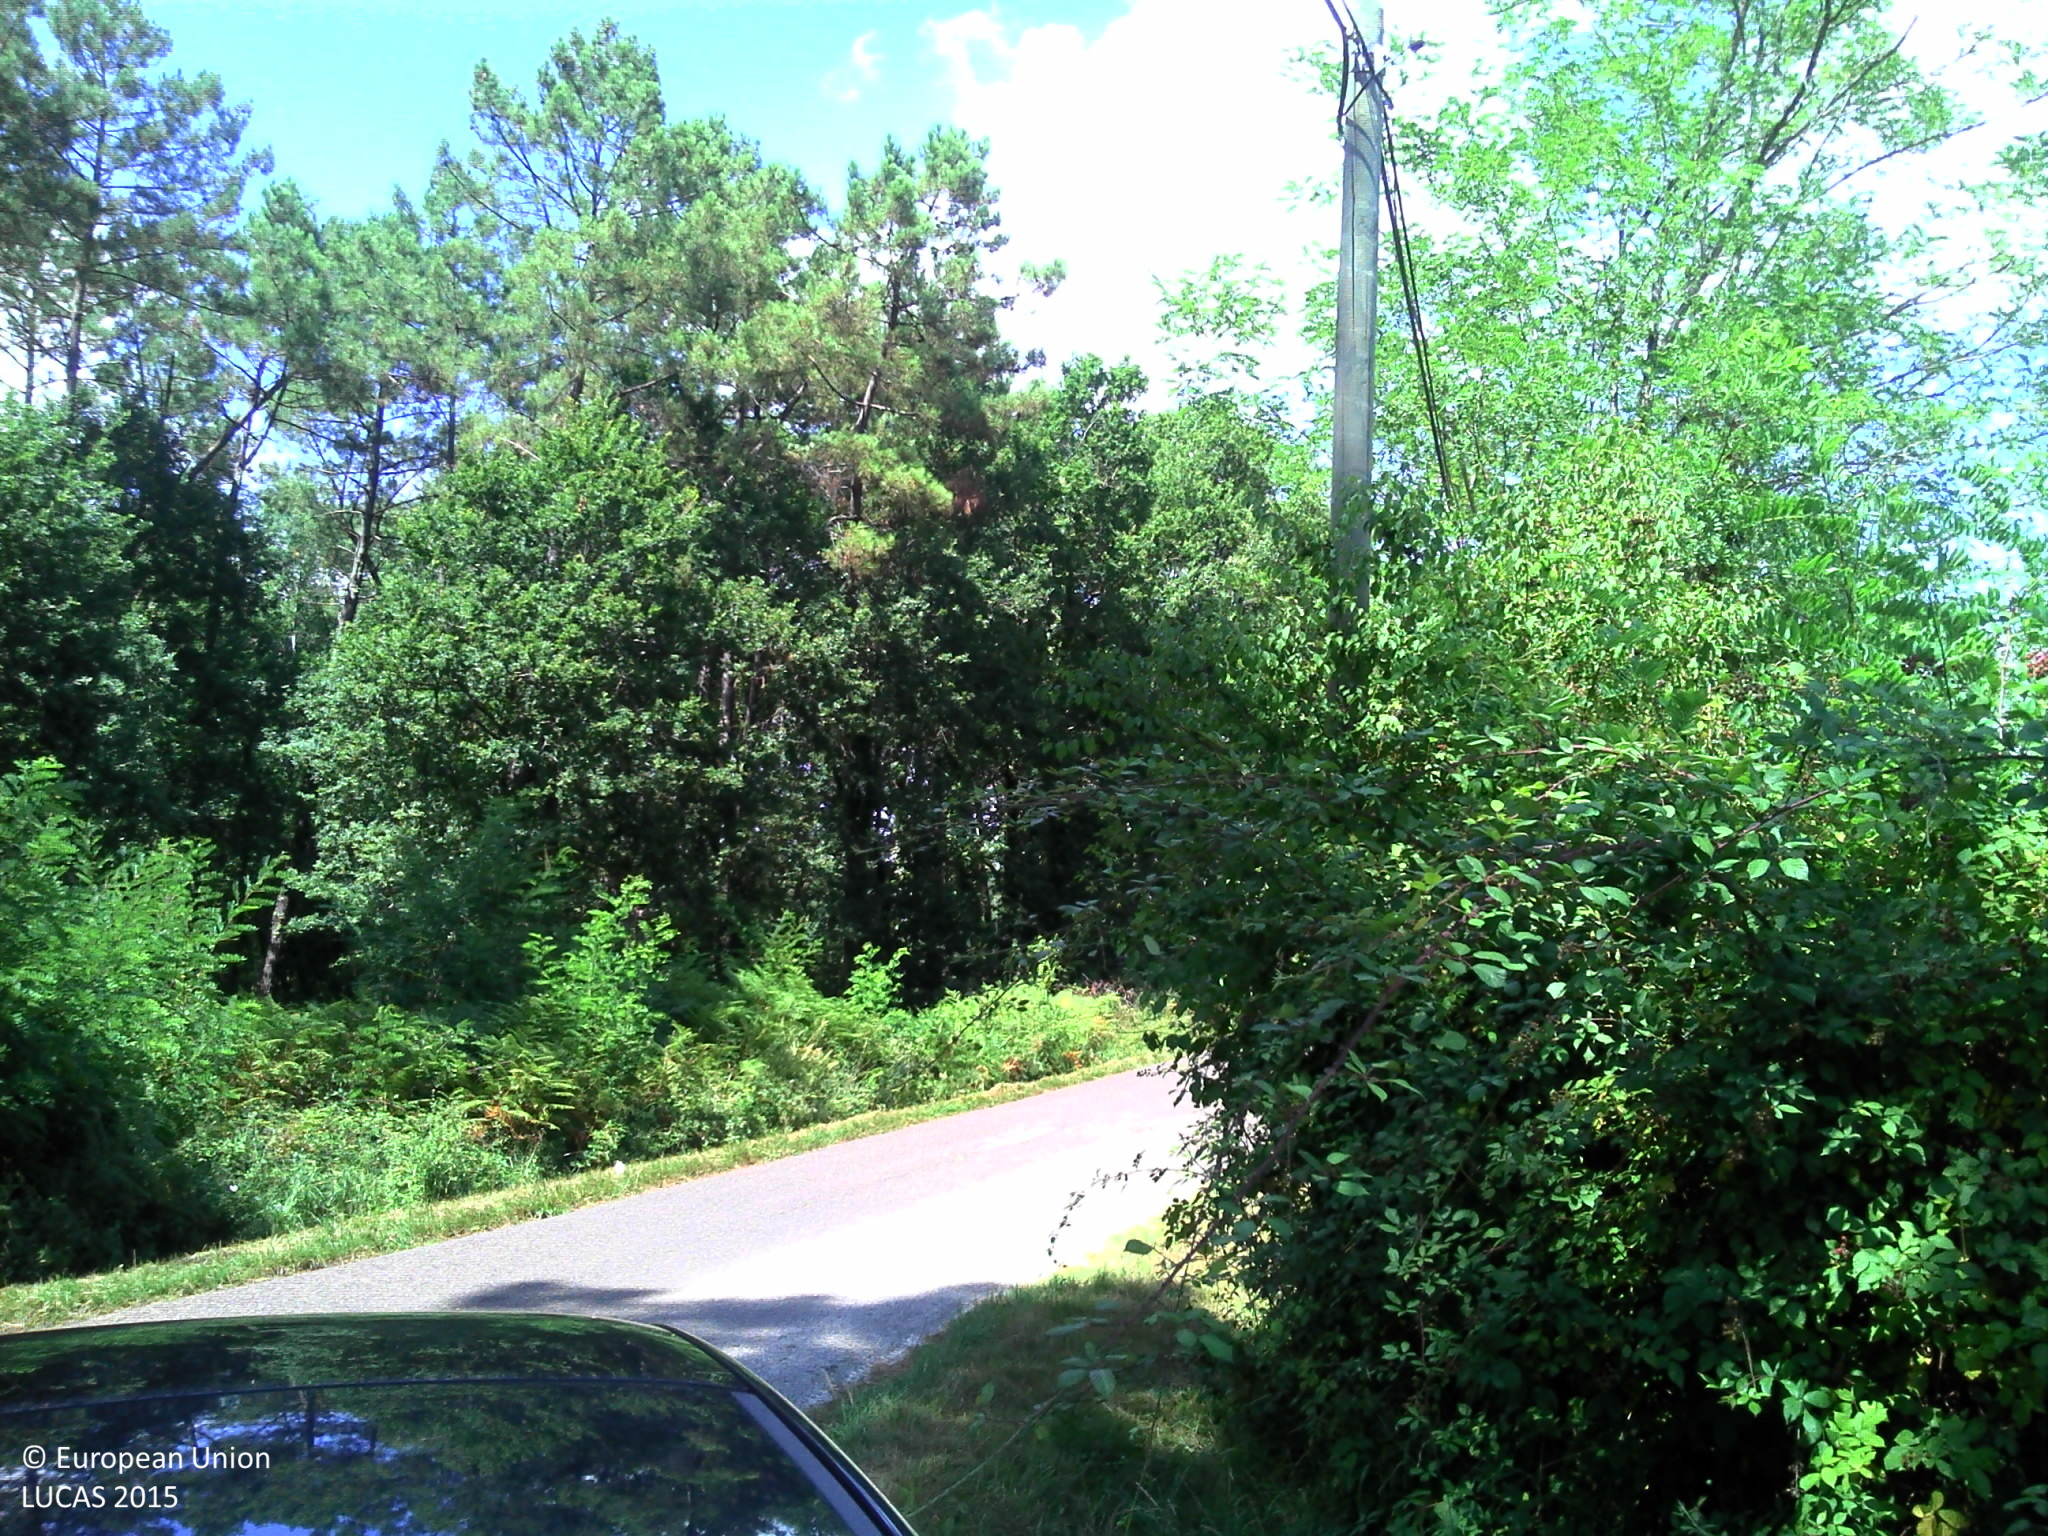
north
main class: Grassland
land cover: Grassland without tree/shrub cover
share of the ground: > 75 %
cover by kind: herbaceous plants 100 %
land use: Agriculture (excluding fallow land and kitchen gardens)
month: July
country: FR
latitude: 43.8682
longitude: -0.5266
